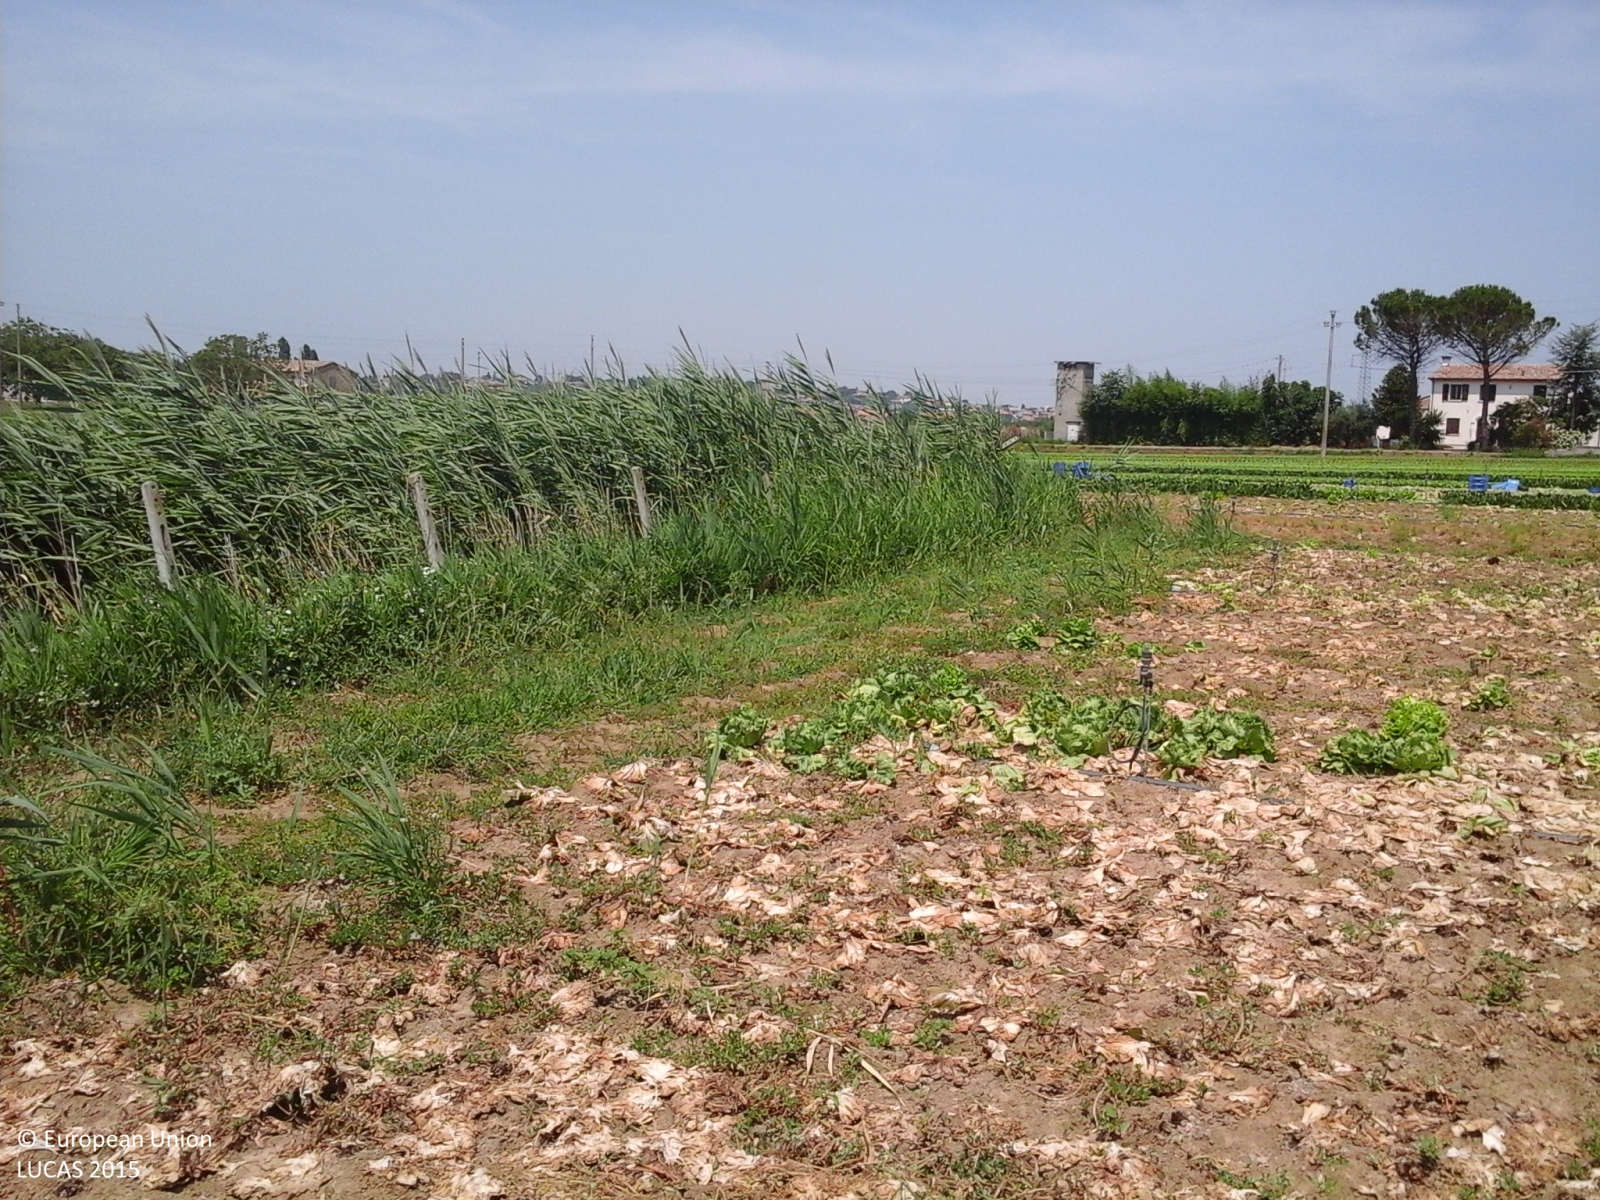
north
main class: Cropland
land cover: Other fresh vegetables
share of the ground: < 10 %
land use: Agriculture (excluding fallow land and kitchen gardens)
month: July
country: IT
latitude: 44.0701
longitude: 12.4042
